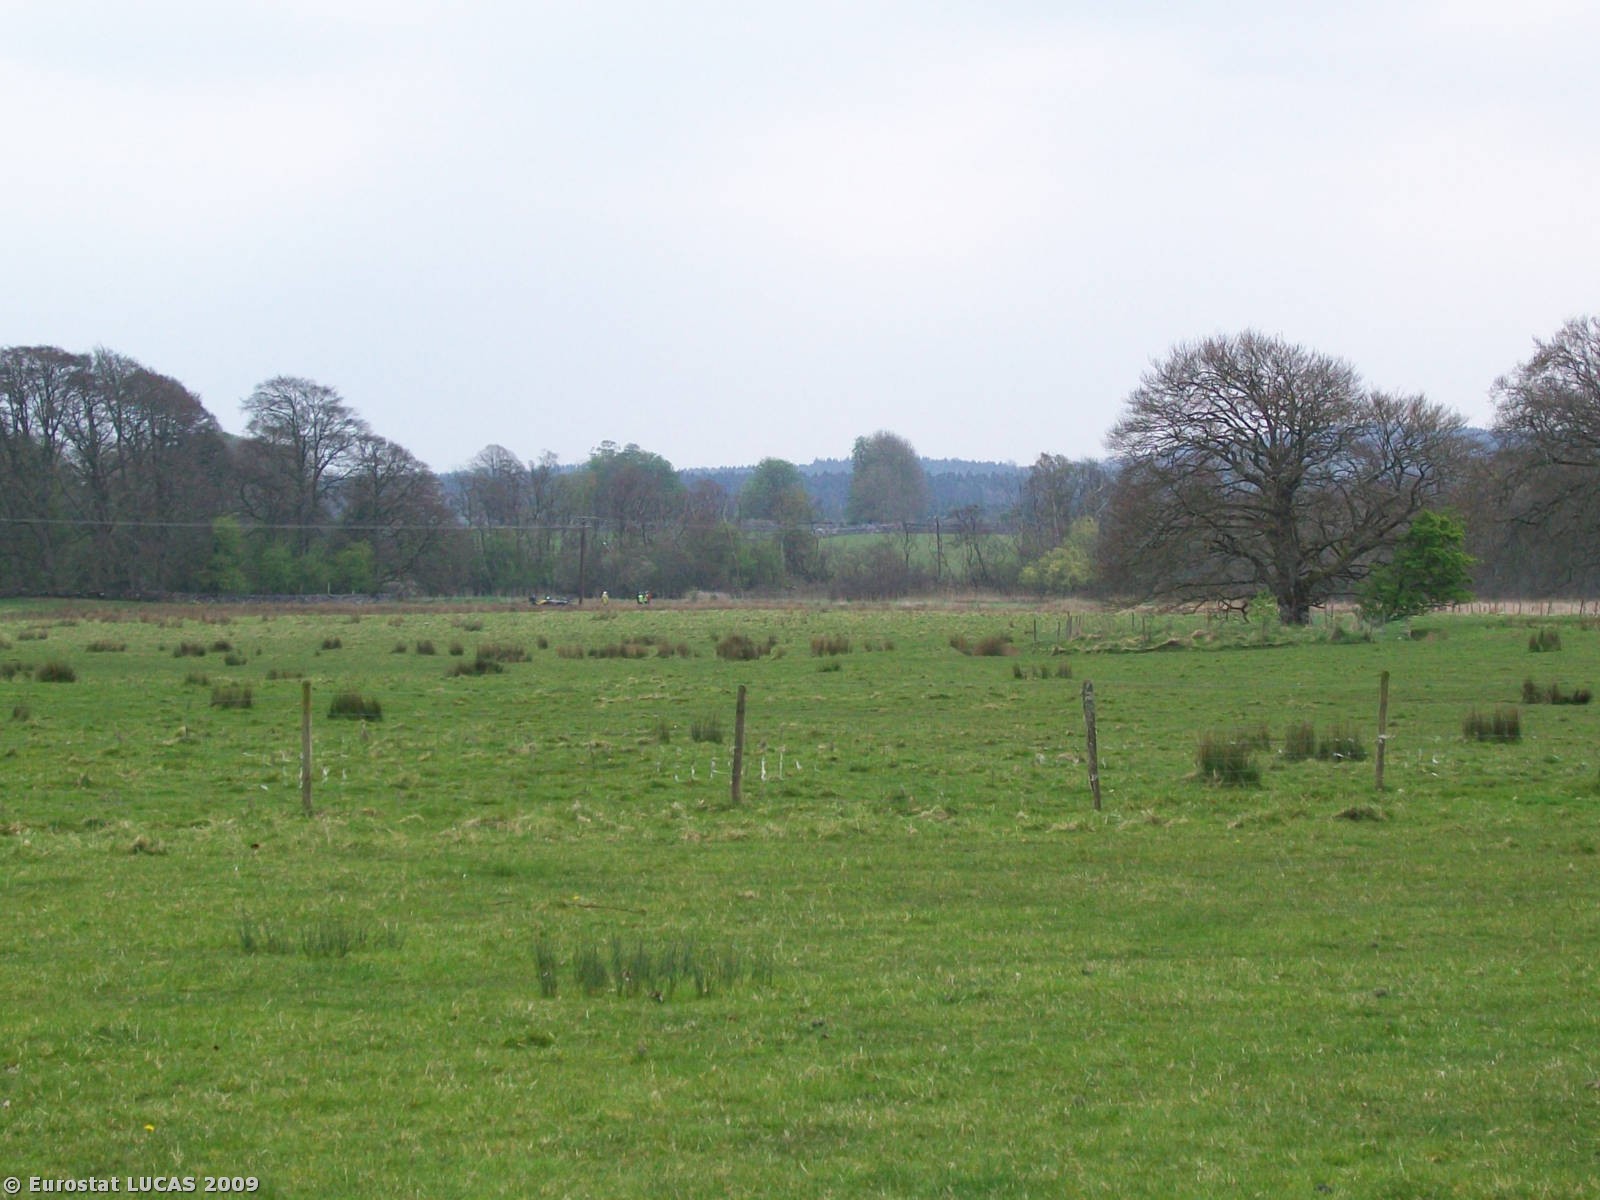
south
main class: Grassland
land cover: Grassland without tree/shrub cover
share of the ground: > 75 %
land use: Agriculture (excluding fallow land and kitchen gardens)
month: April
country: IE
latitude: 53.6185
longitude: -8.1554
